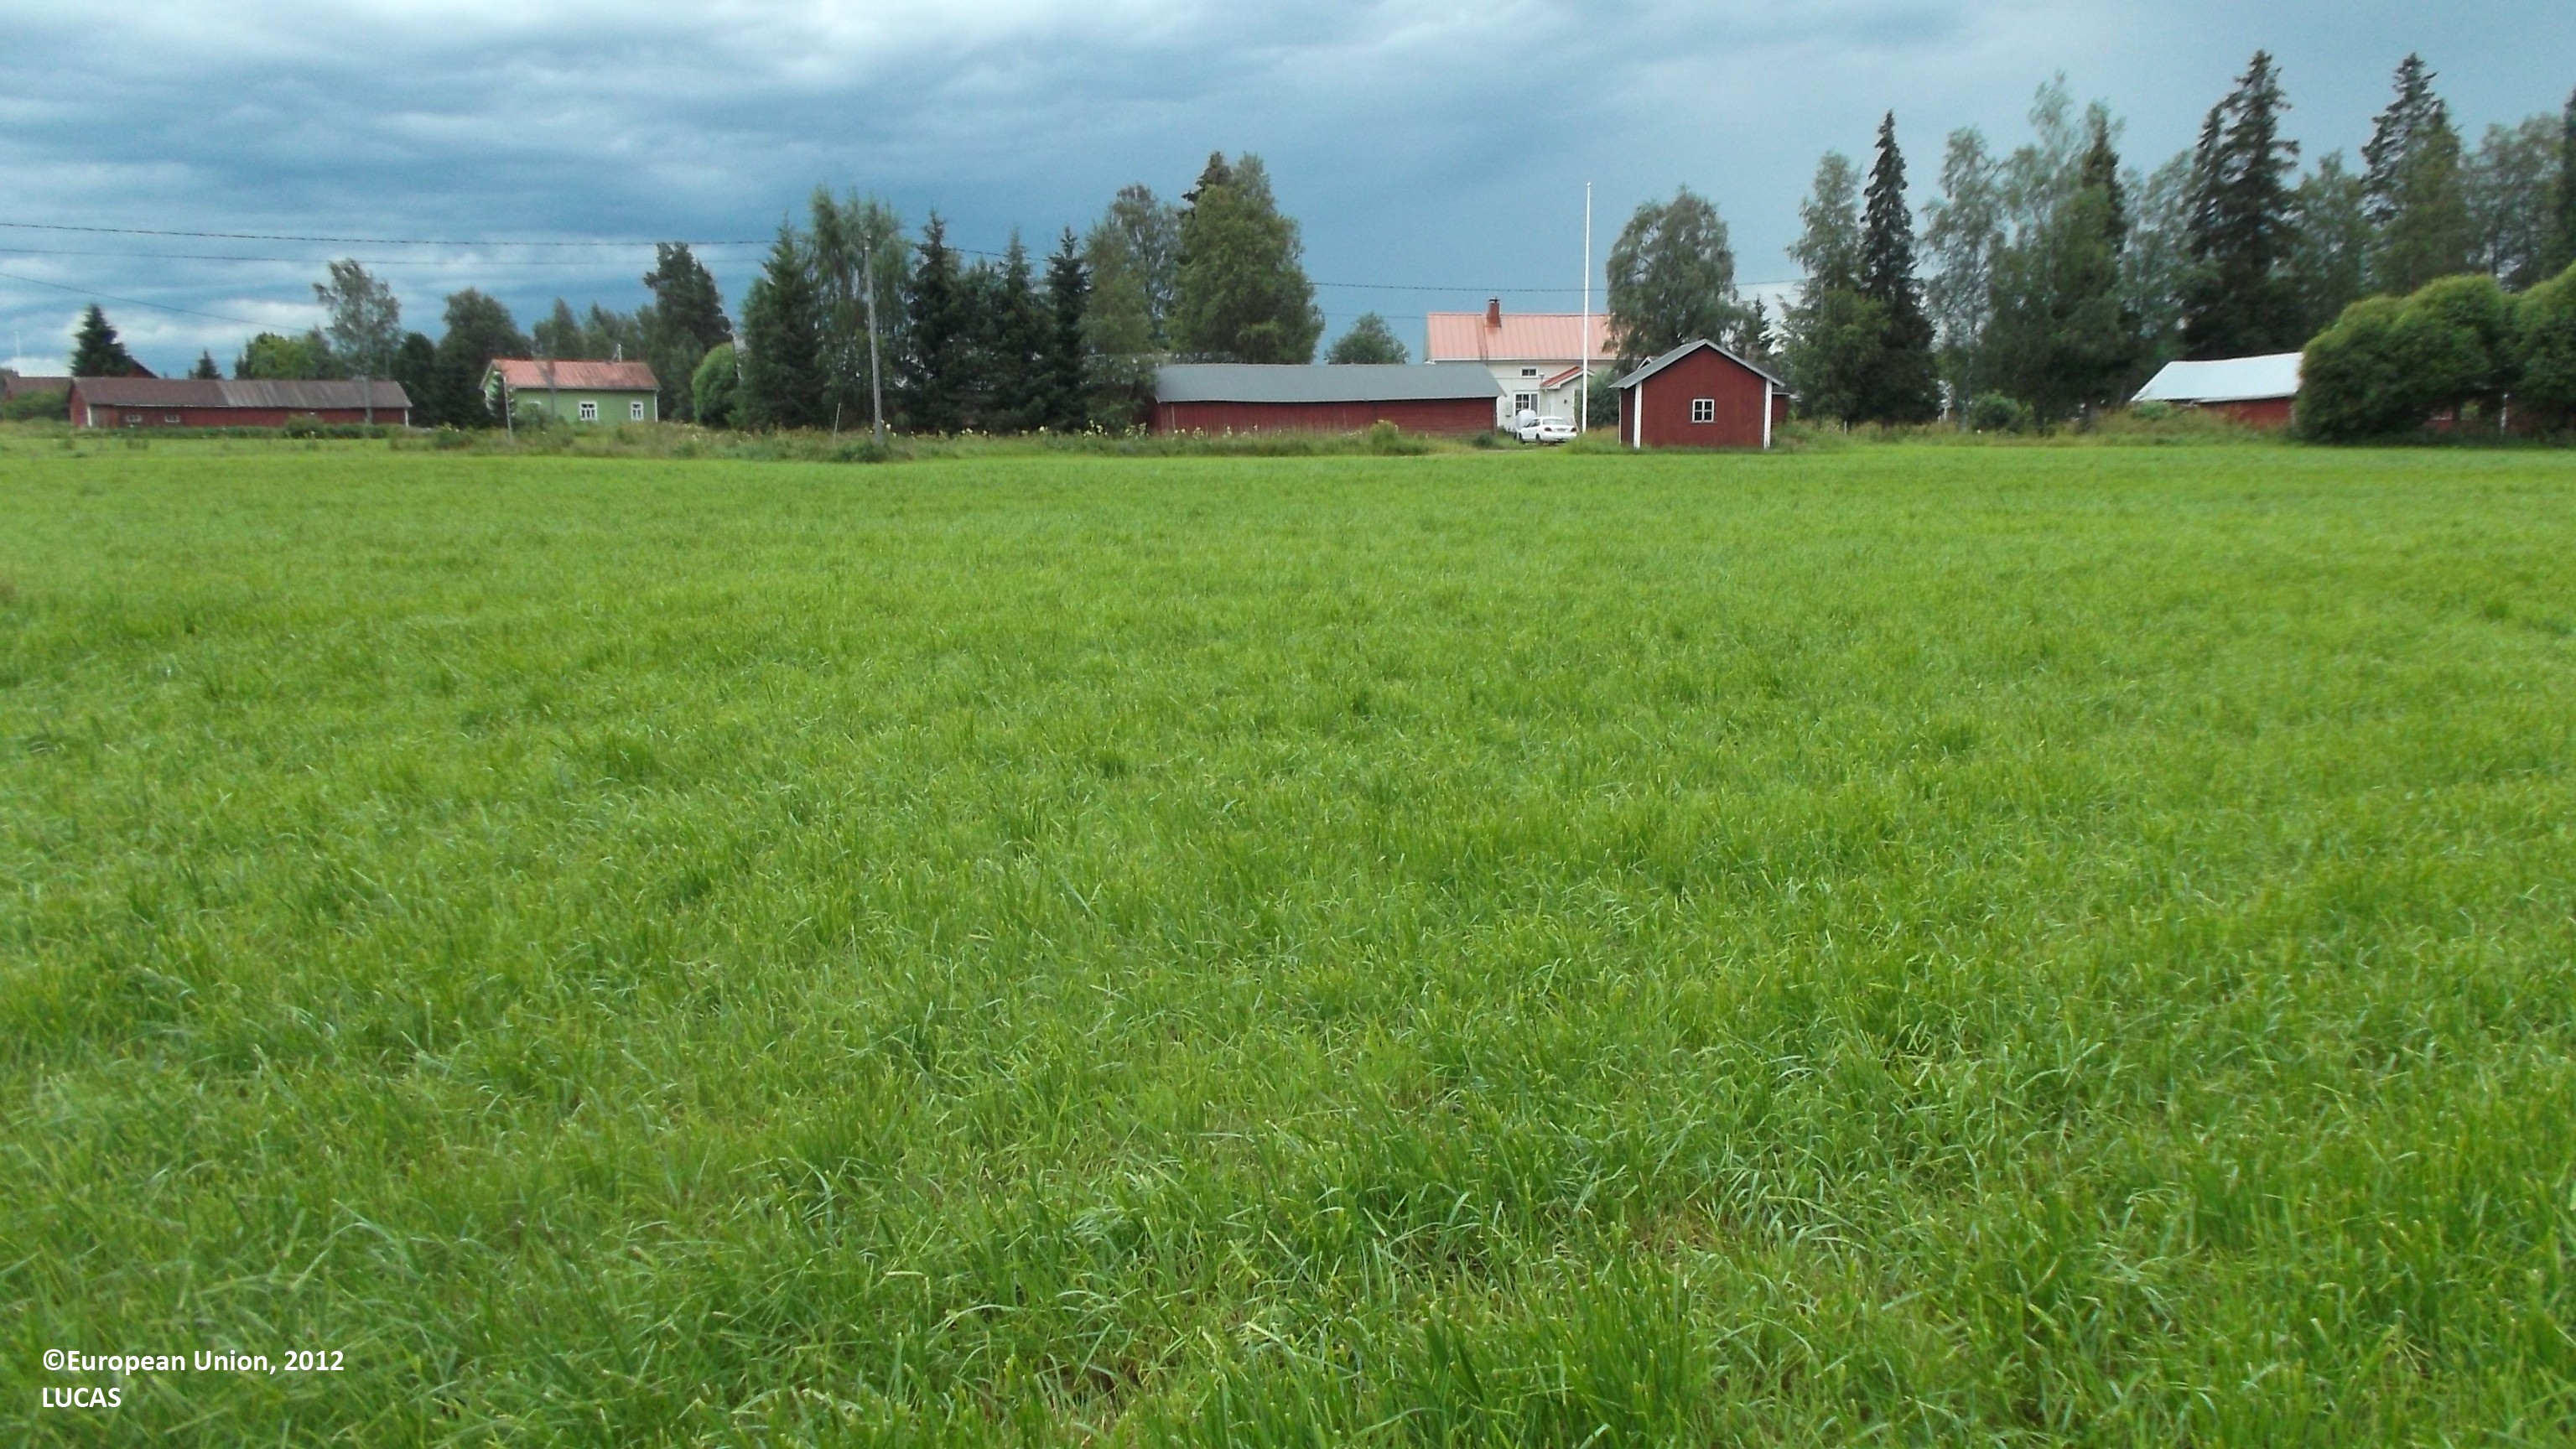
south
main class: Cropland
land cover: Temporary grasslands
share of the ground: > 75 %
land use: Agriculture (excluding fallow land and kitchen gardens)
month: August
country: FI
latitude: 64.0379
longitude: 23.5079
